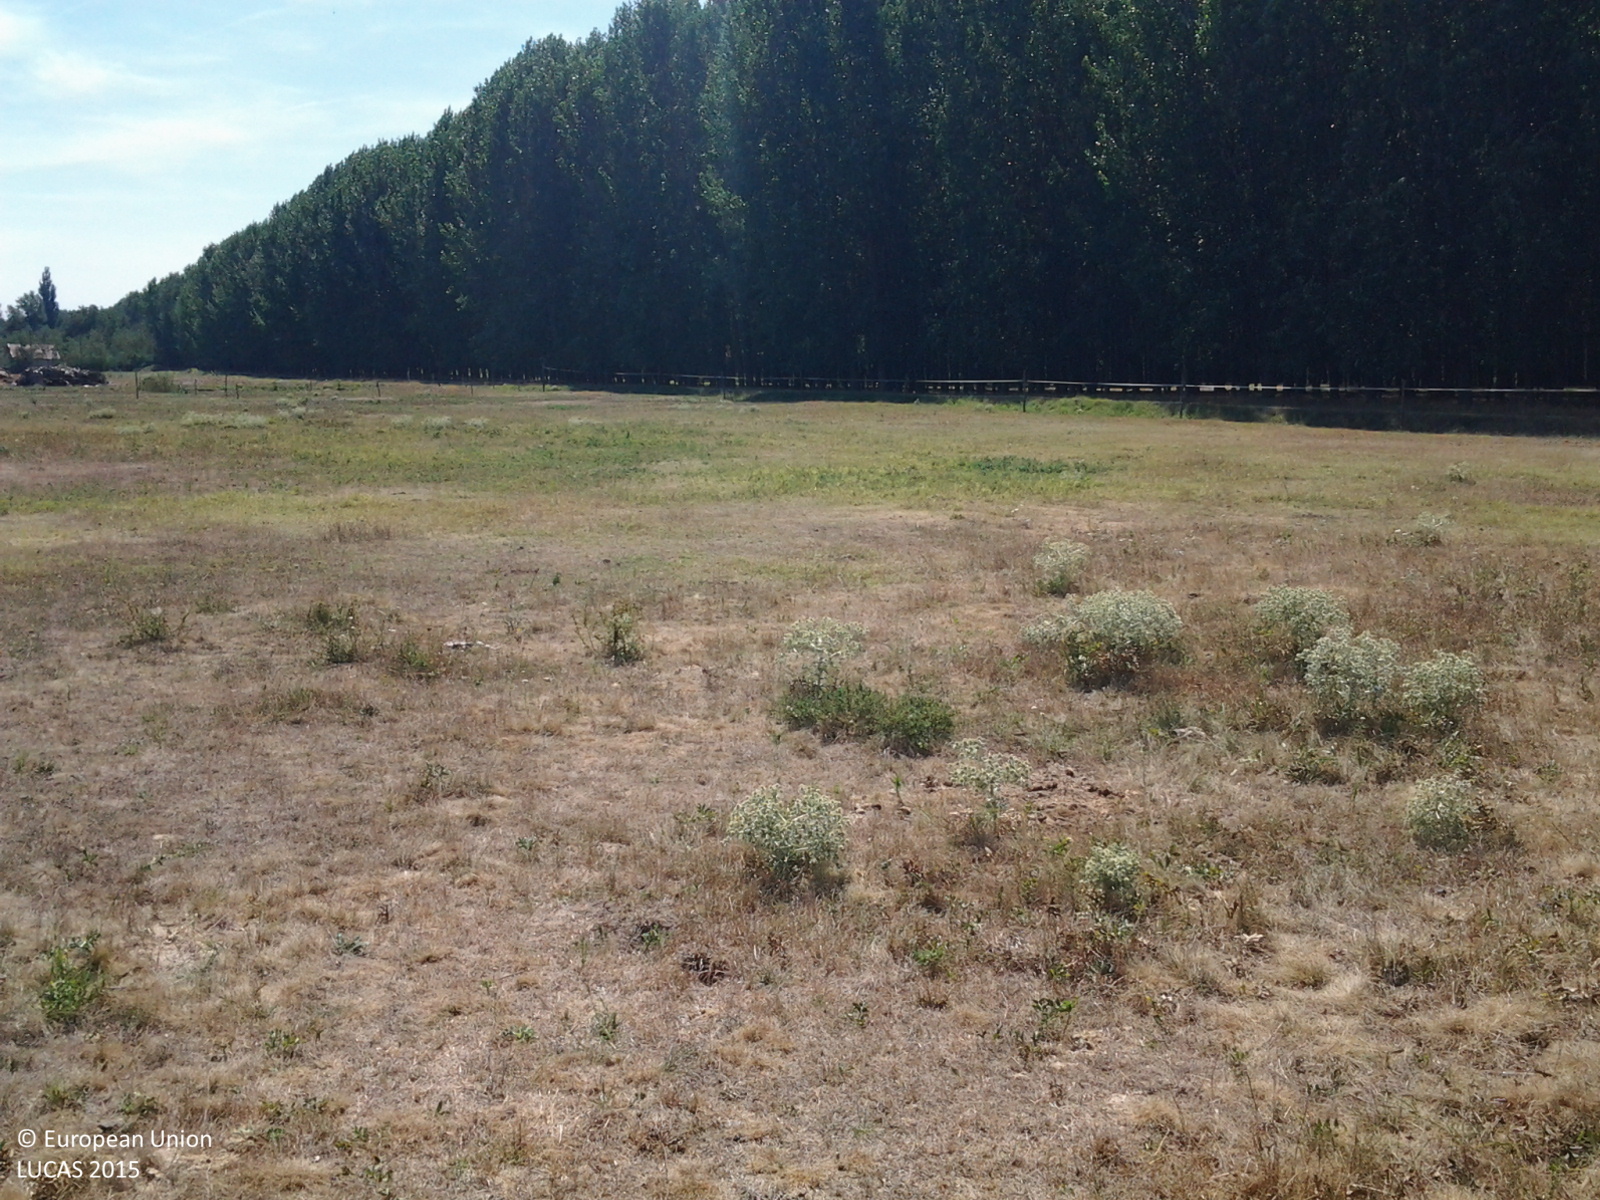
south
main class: Grassland
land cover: Grassland without tree/shrub cover
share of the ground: > 75 %
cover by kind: herbaceous plants 100 %
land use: Agriculture (excluding fallow land and kitchen gardens)
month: August
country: HU
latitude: 47.3883
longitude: 19.7867
